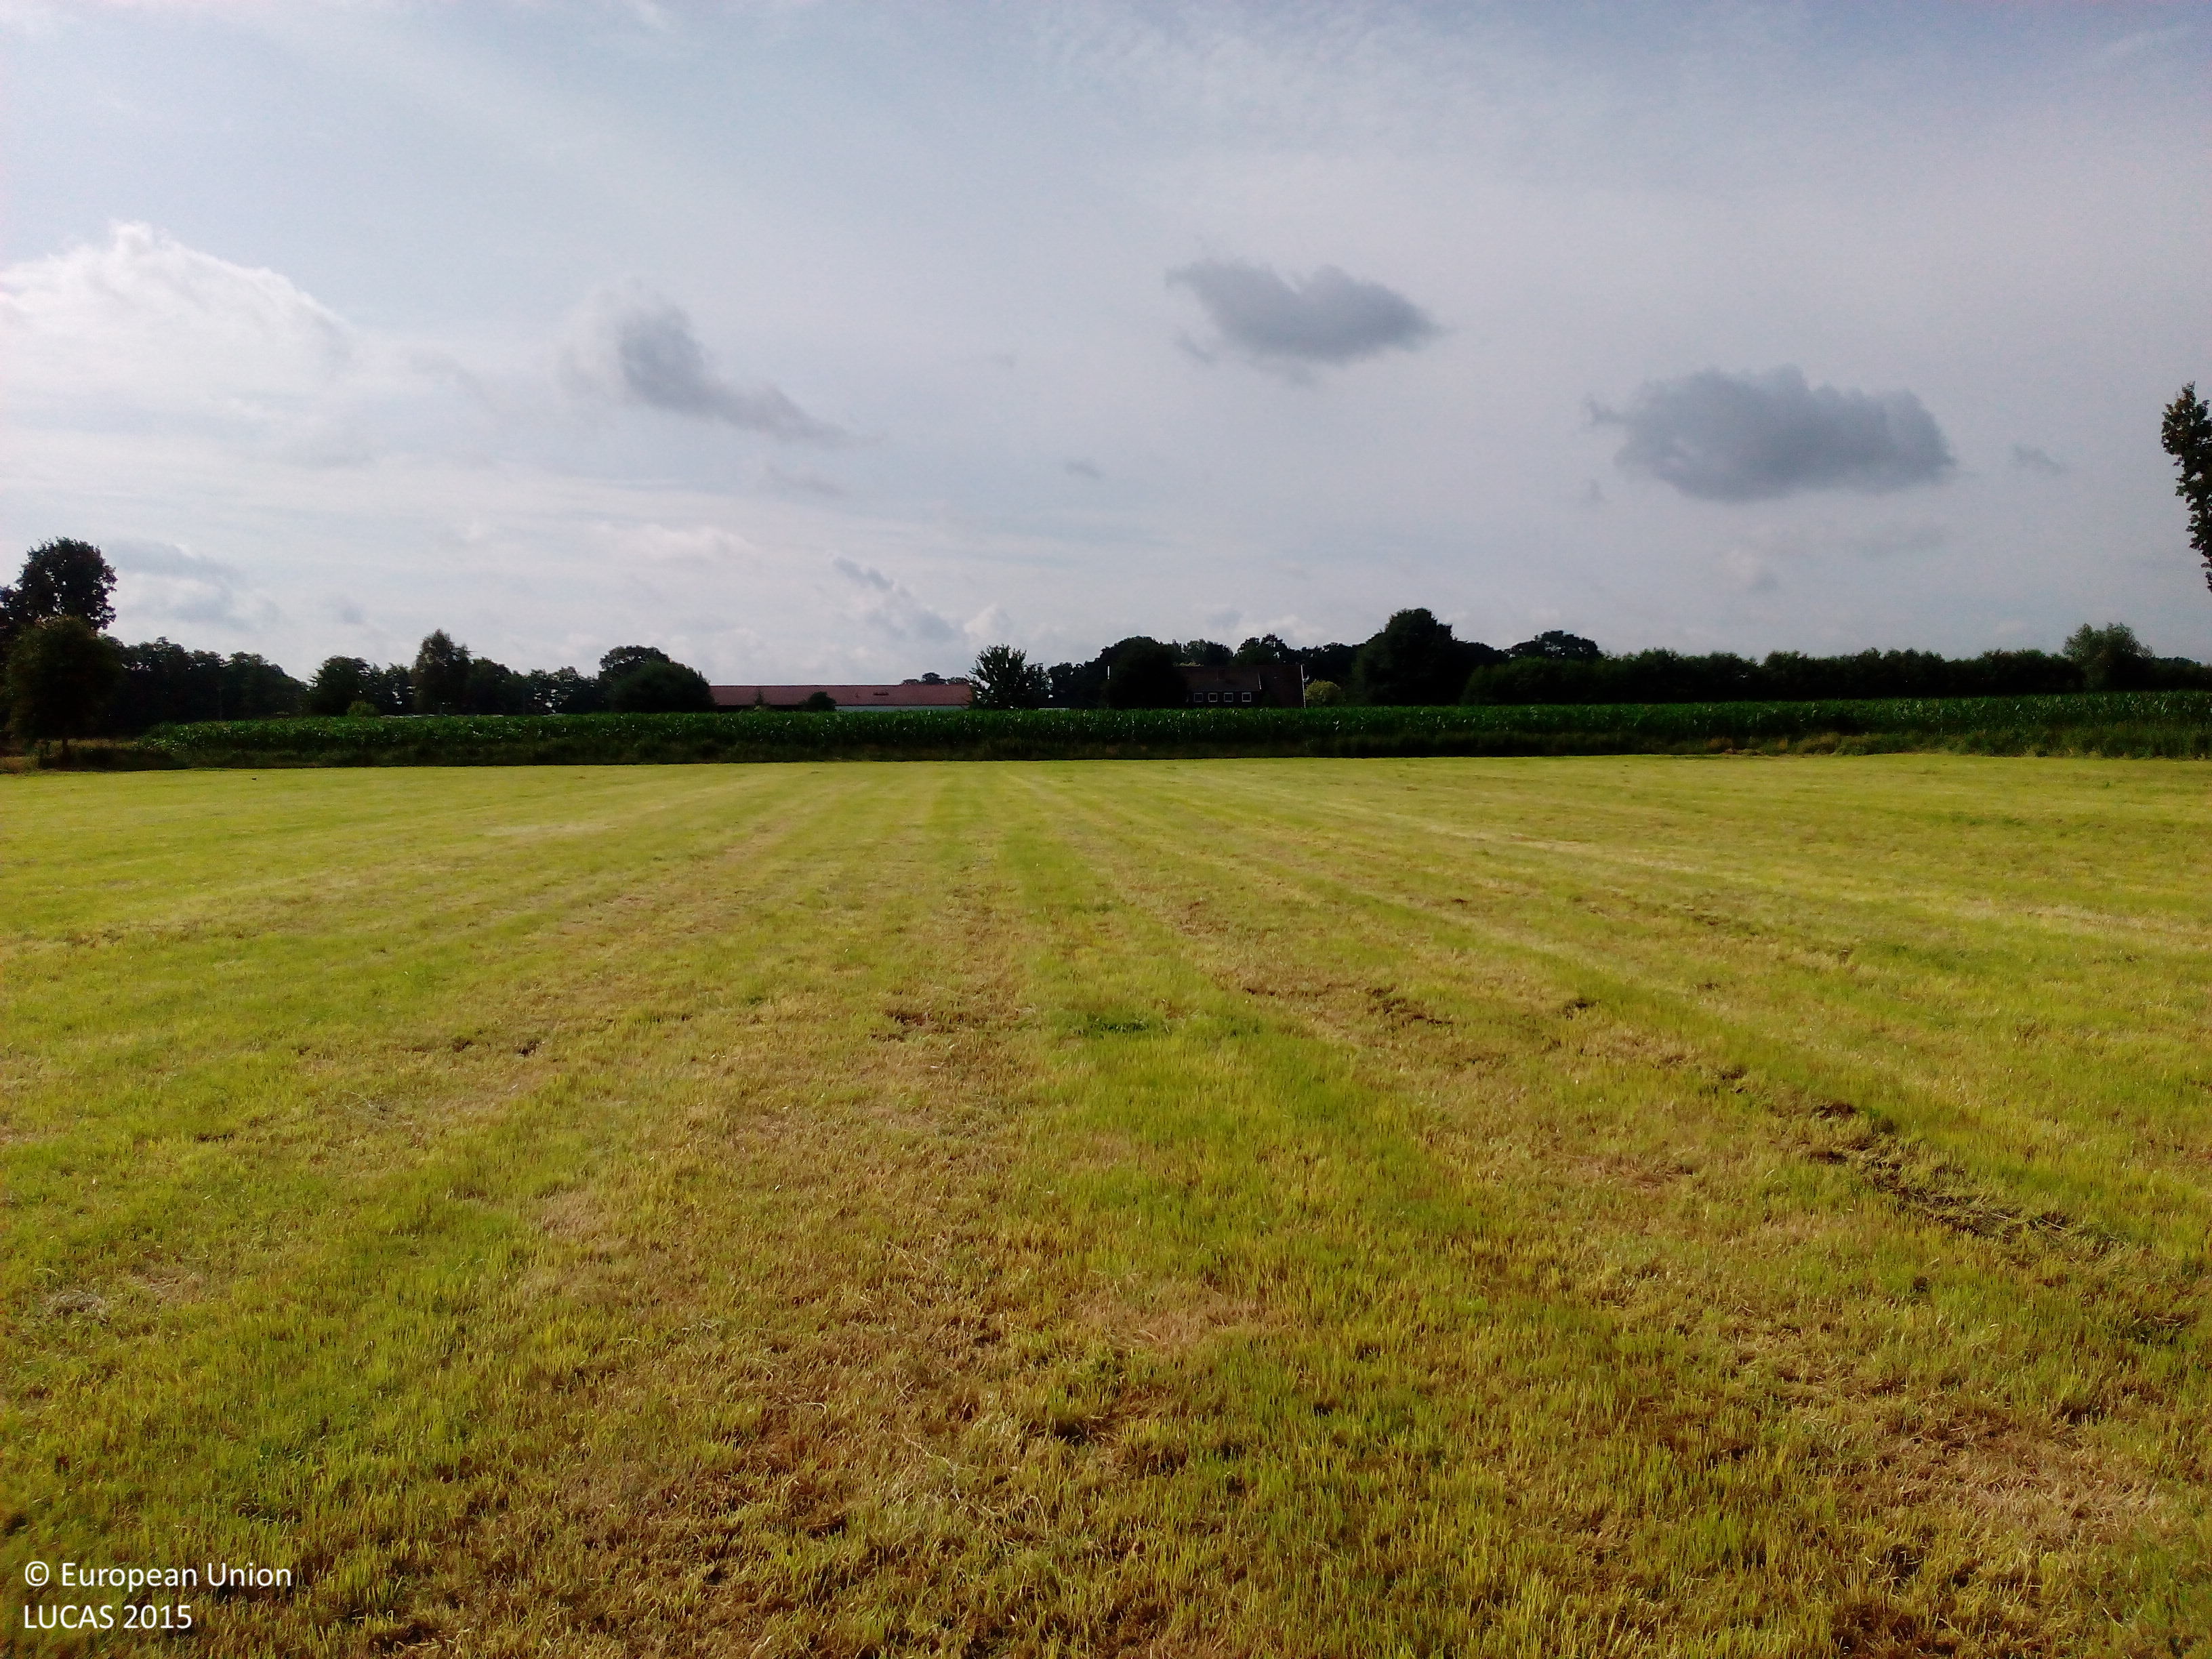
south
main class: Grassland
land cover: Grassland without tree/shrub cover
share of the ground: > 75 %
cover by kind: herbaceous plants 100 %
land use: Agriculture (excluding fallow land and kitchen gardens)
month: July
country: DE
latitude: 52.5945
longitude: 8.0076
